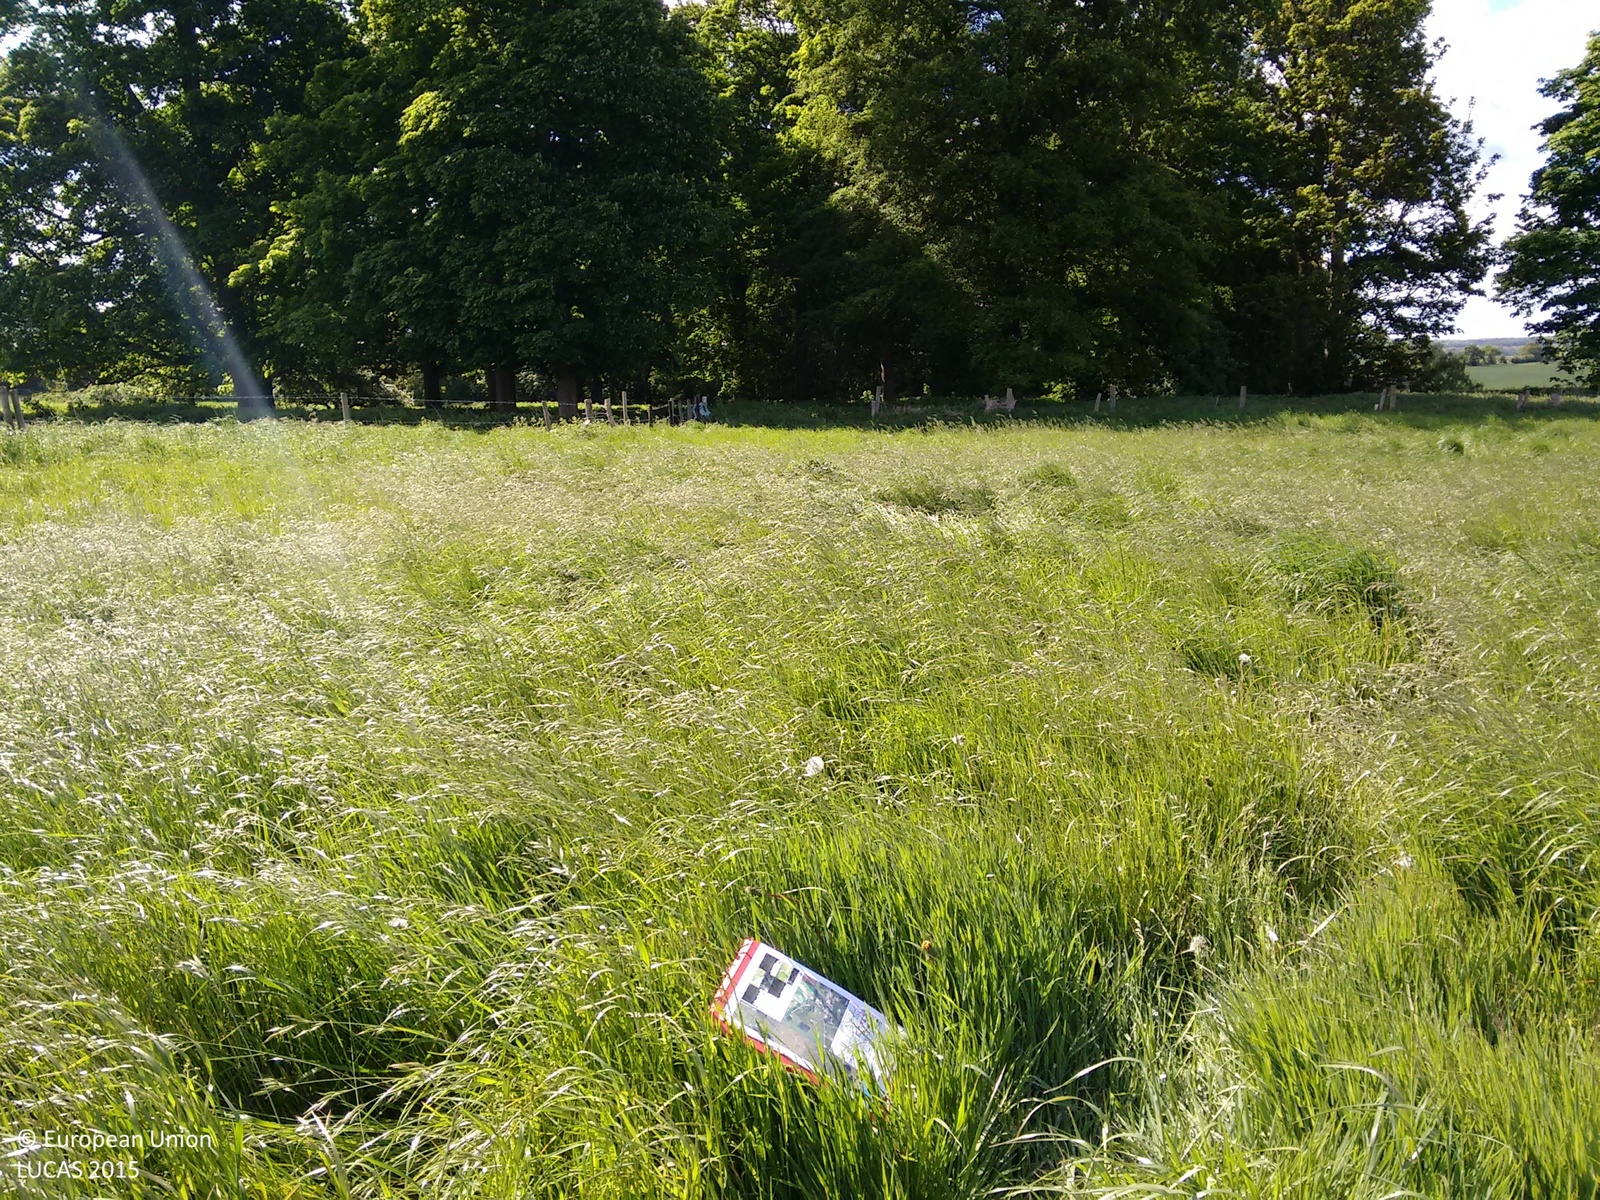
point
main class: Grassland
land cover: Grassland without tree/shrub cover
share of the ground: > 75 %
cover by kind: herbaceous plants 100 %
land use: Agriculture (excluding fallow land and kitchen gardens)
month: May
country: GB
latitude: 53.5611
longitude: -0.2857
